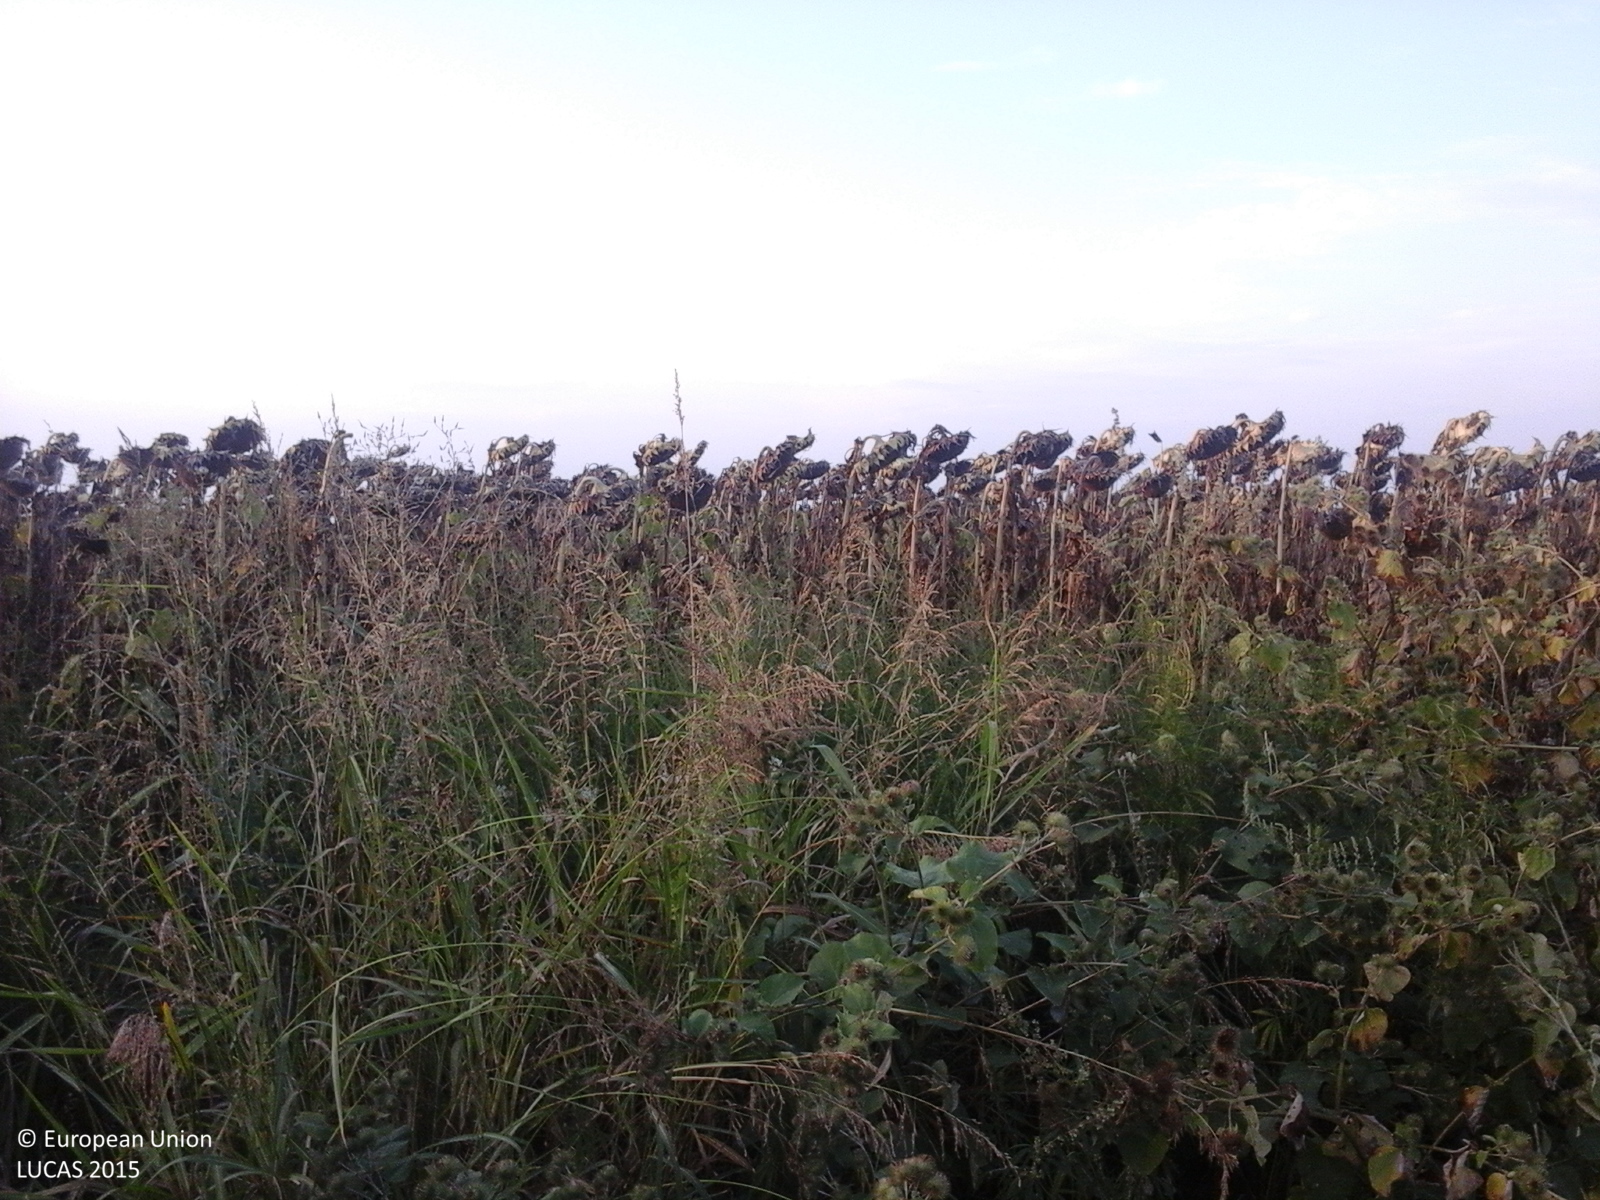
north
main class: Cropland
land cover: Sunflower
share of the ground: > 75 %
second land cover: Spontaneously vegetated surfaces
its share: 50 - 75 %
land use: Agriculture (excluding fallow land and kitchen gardens)
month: August
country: RO
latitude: 43.8900
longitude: 23.4538
